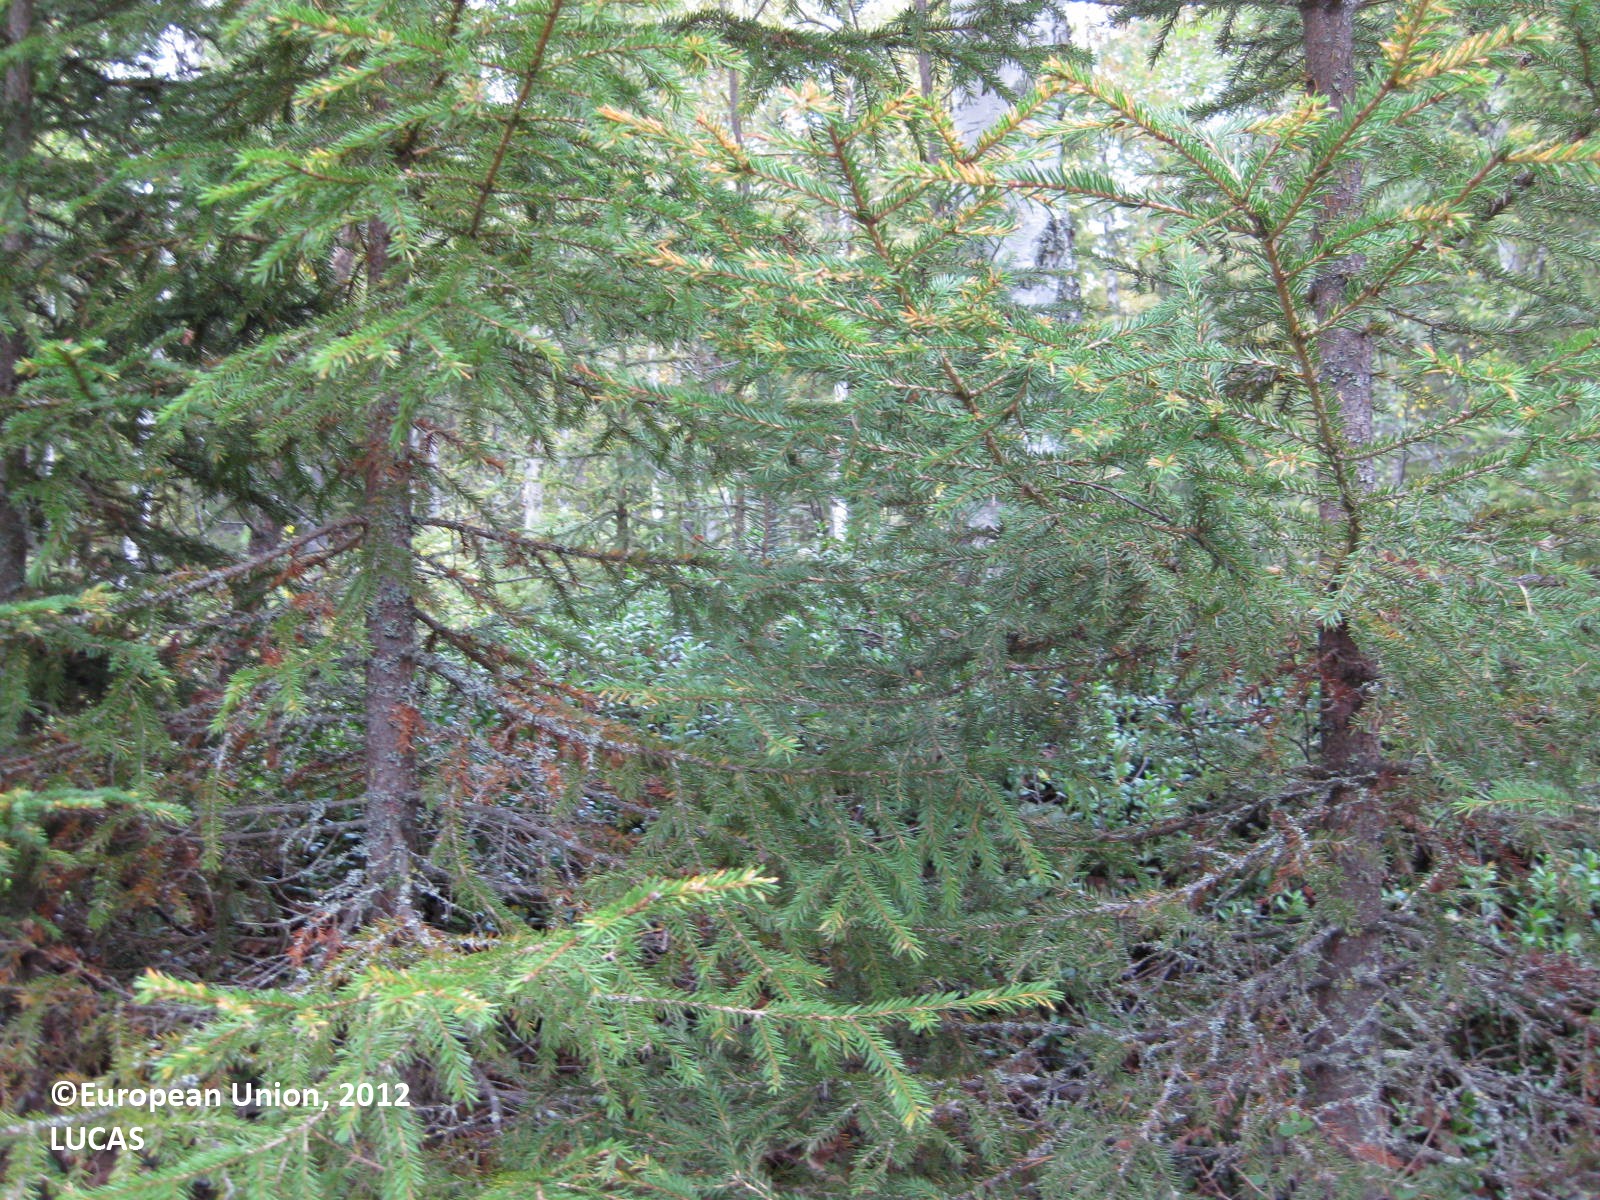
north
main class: Woodland
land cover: Other mixed woodland
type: boreal forest
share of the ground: 50 - 75 %
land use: Forestry
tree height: > 5 m
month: August
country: FI
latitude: 65.9650
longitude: 29.8079
